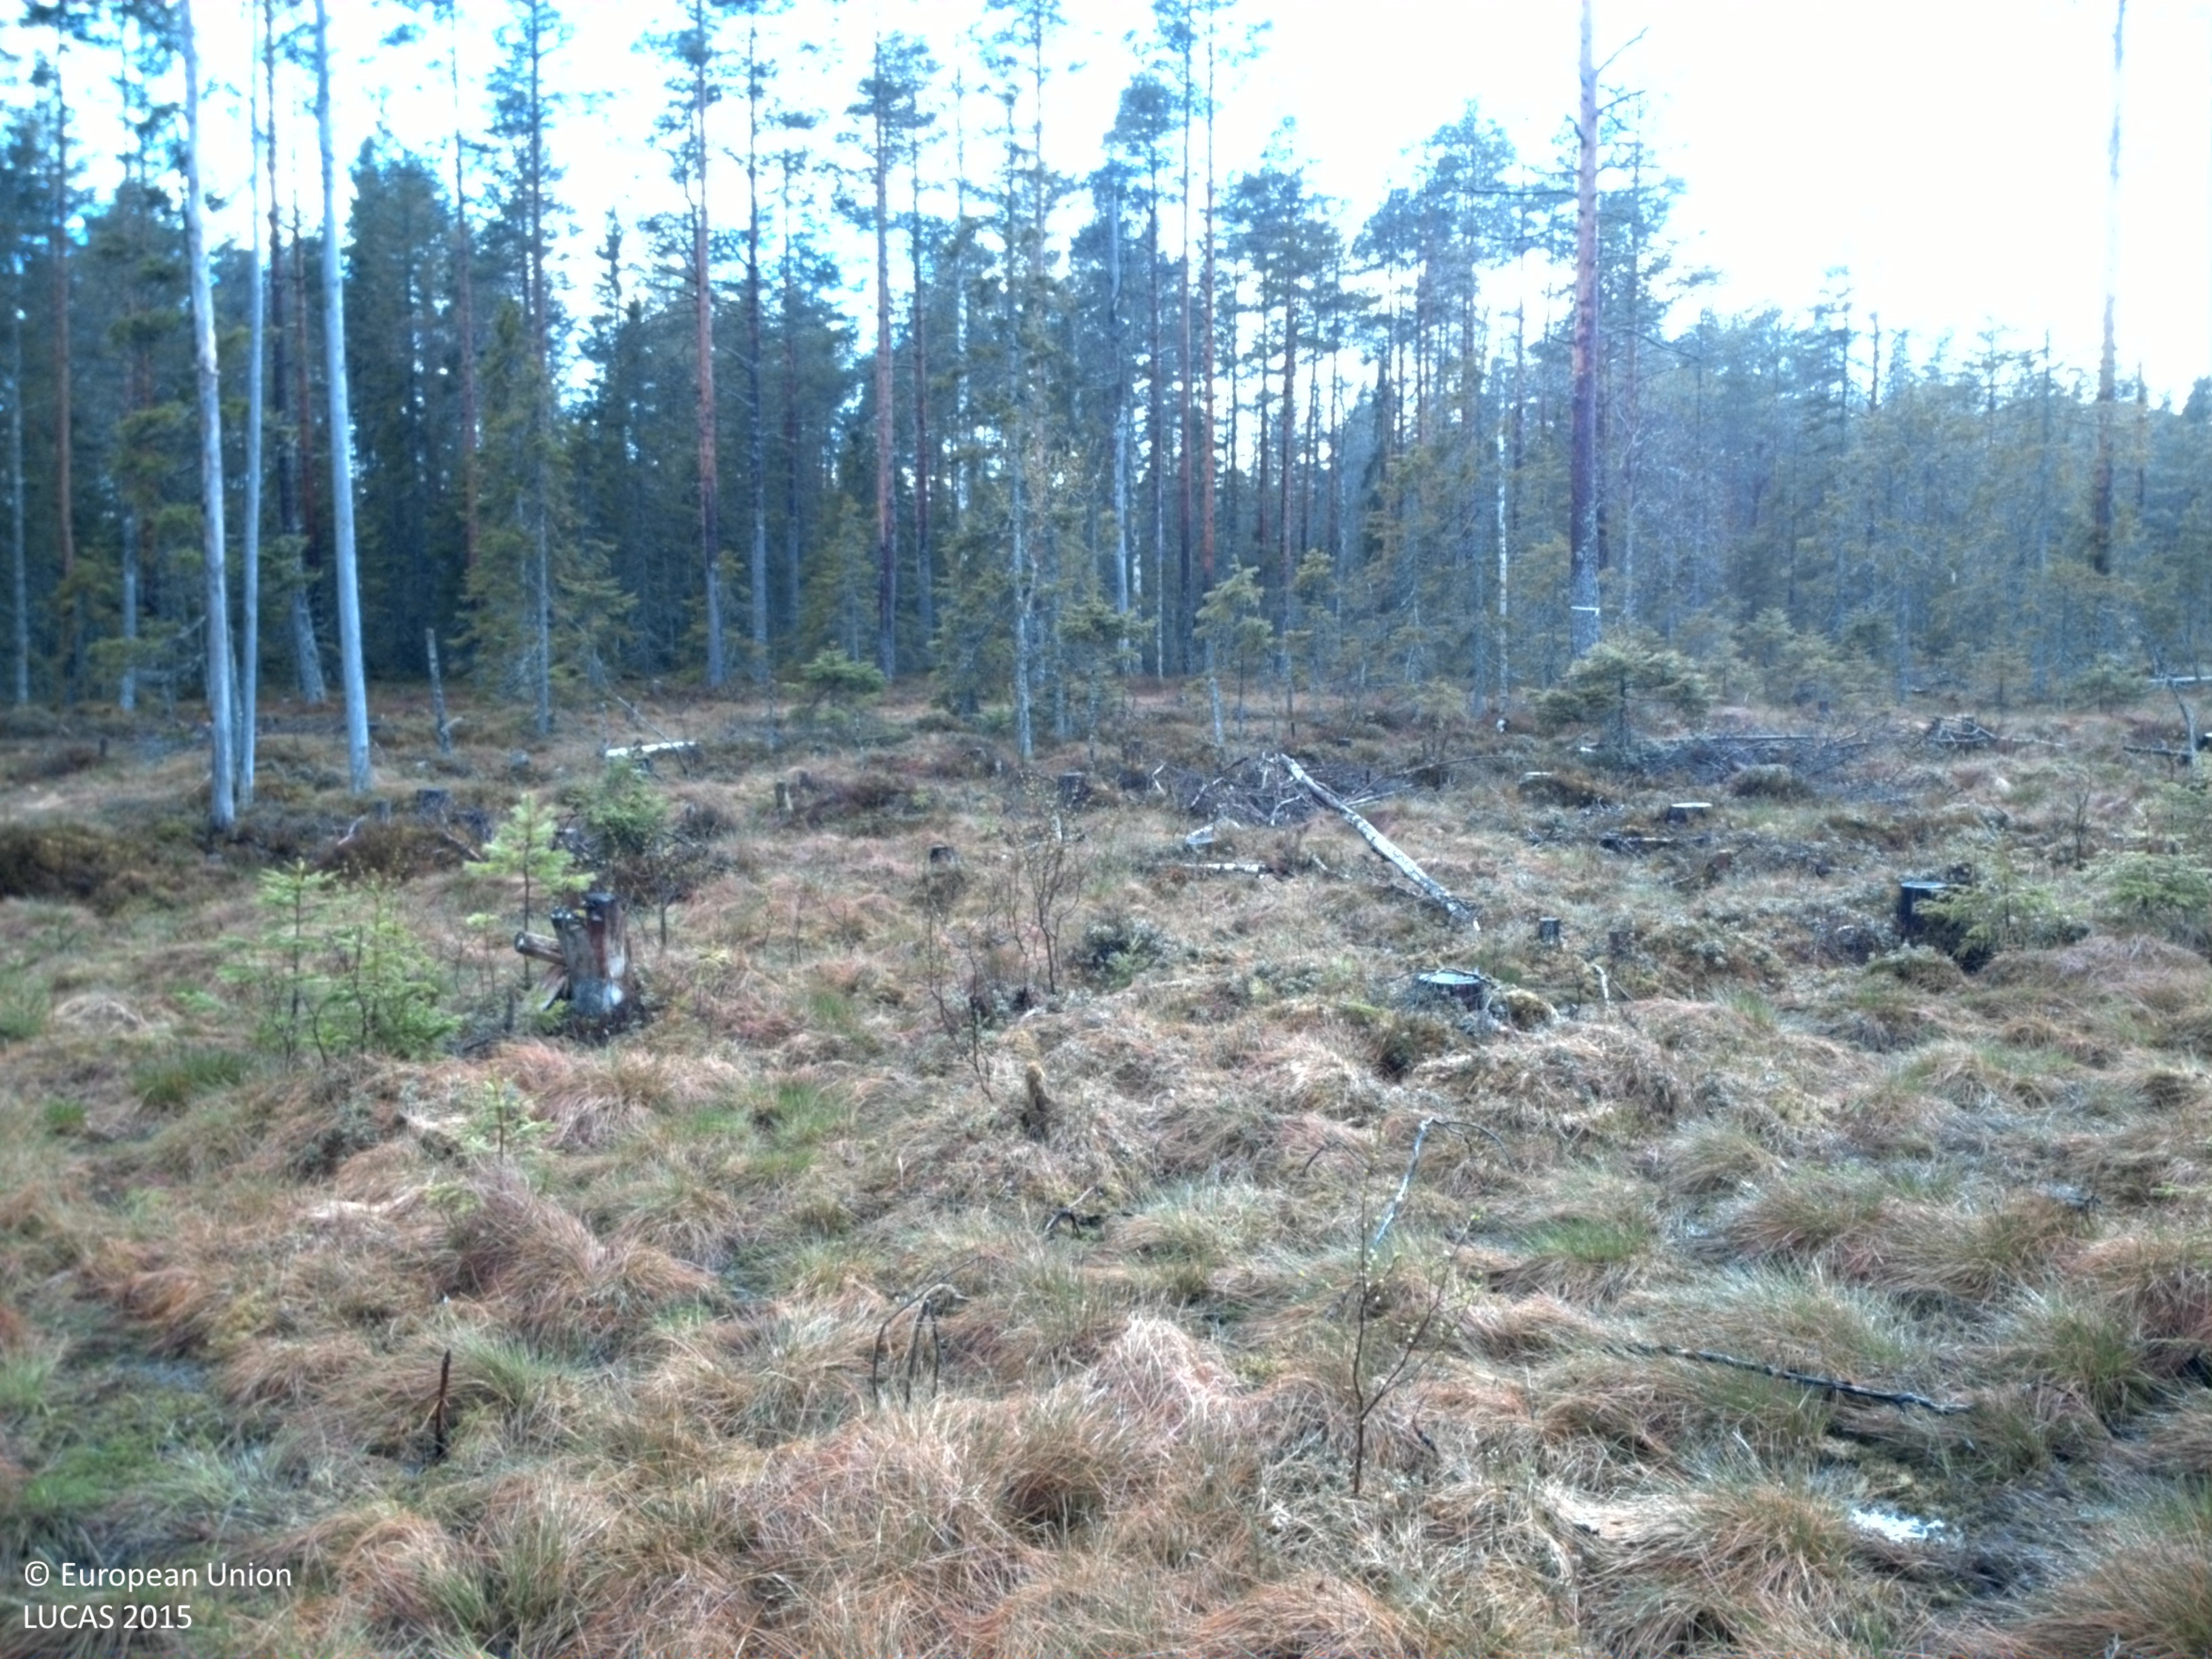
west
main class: Woodland
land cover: Spruce dominated mixed woodland
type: boreal forest
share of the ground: > 75 %
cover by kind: coniferous forest trees 55 %, broadleaved forest trees 25 %, herbaceous plants 10 %, shrubs 5 %, lichens and mosses 5 %
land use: Forestry
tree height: > 5 m
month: May
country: SE
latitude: 61.1444
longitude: 14.8339
